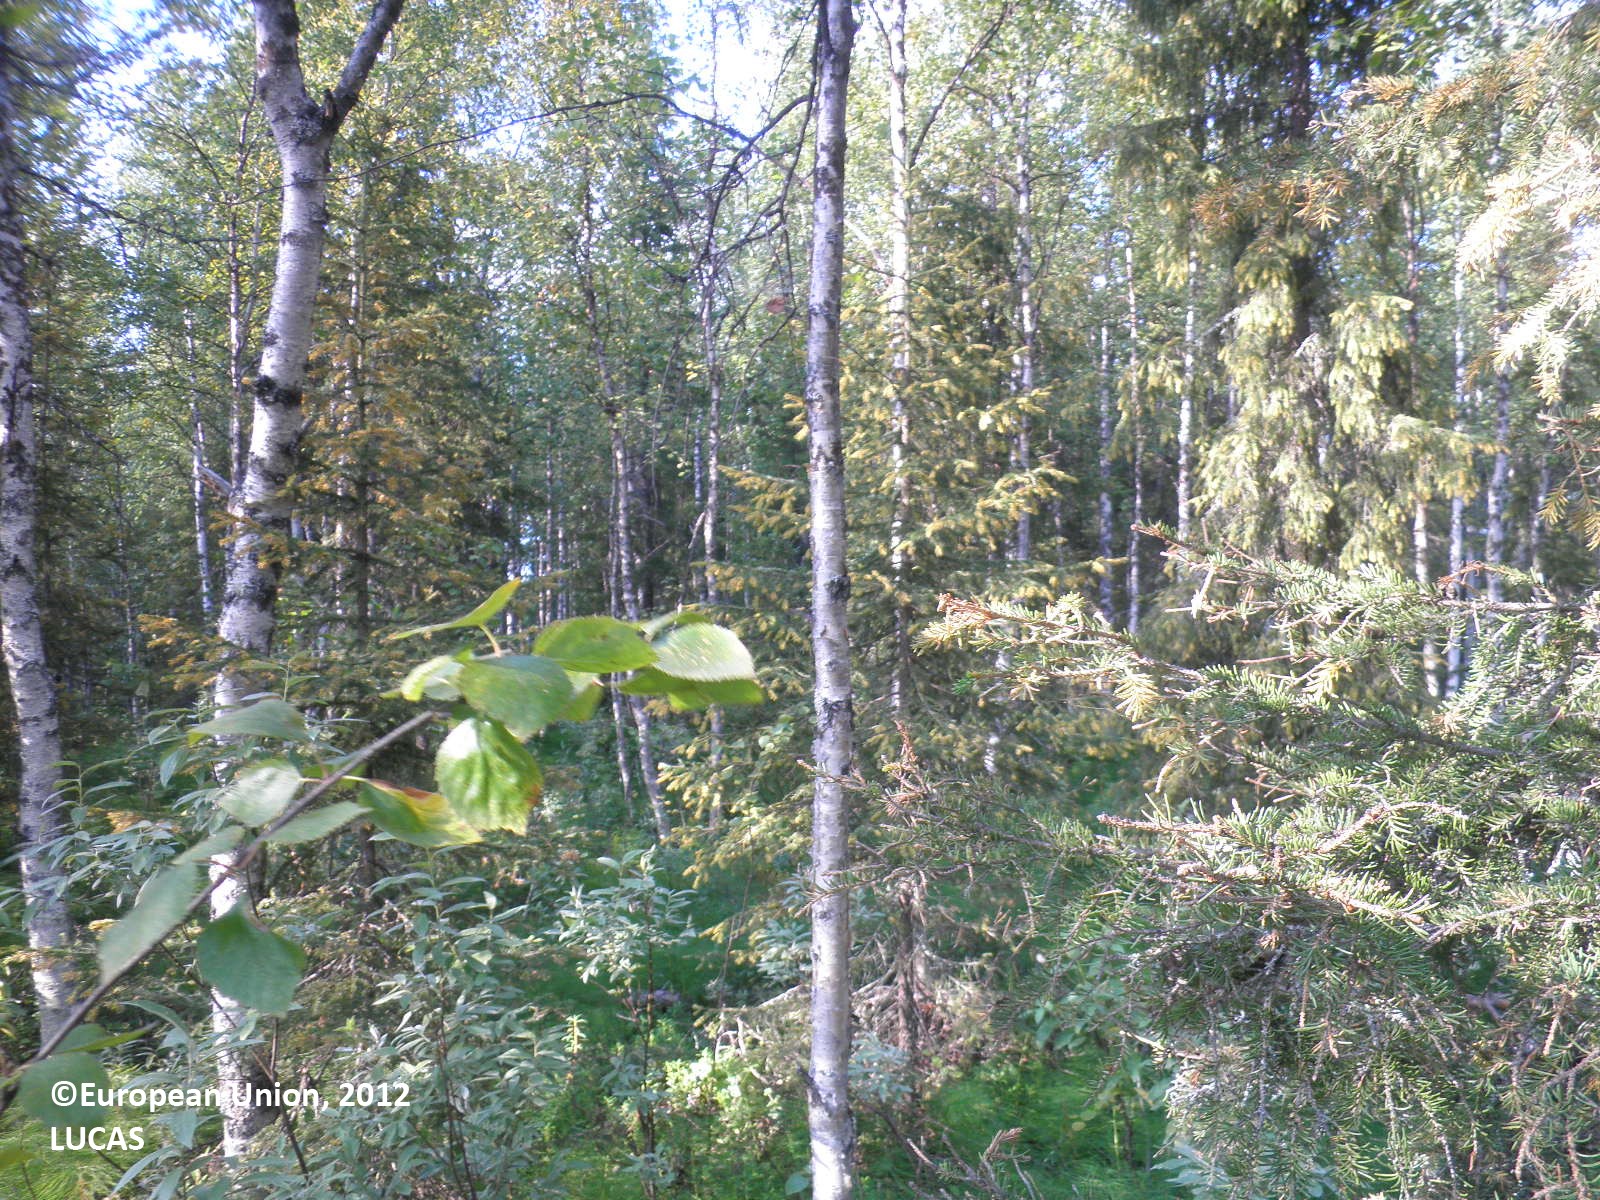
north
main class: Woodland
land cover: Spruce dominated mixed woodland
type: boreal forest
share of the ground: > 75 %
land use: Forestry
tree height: > 5 m
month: August
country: FI
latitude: 67.5382
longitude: 25.5049
